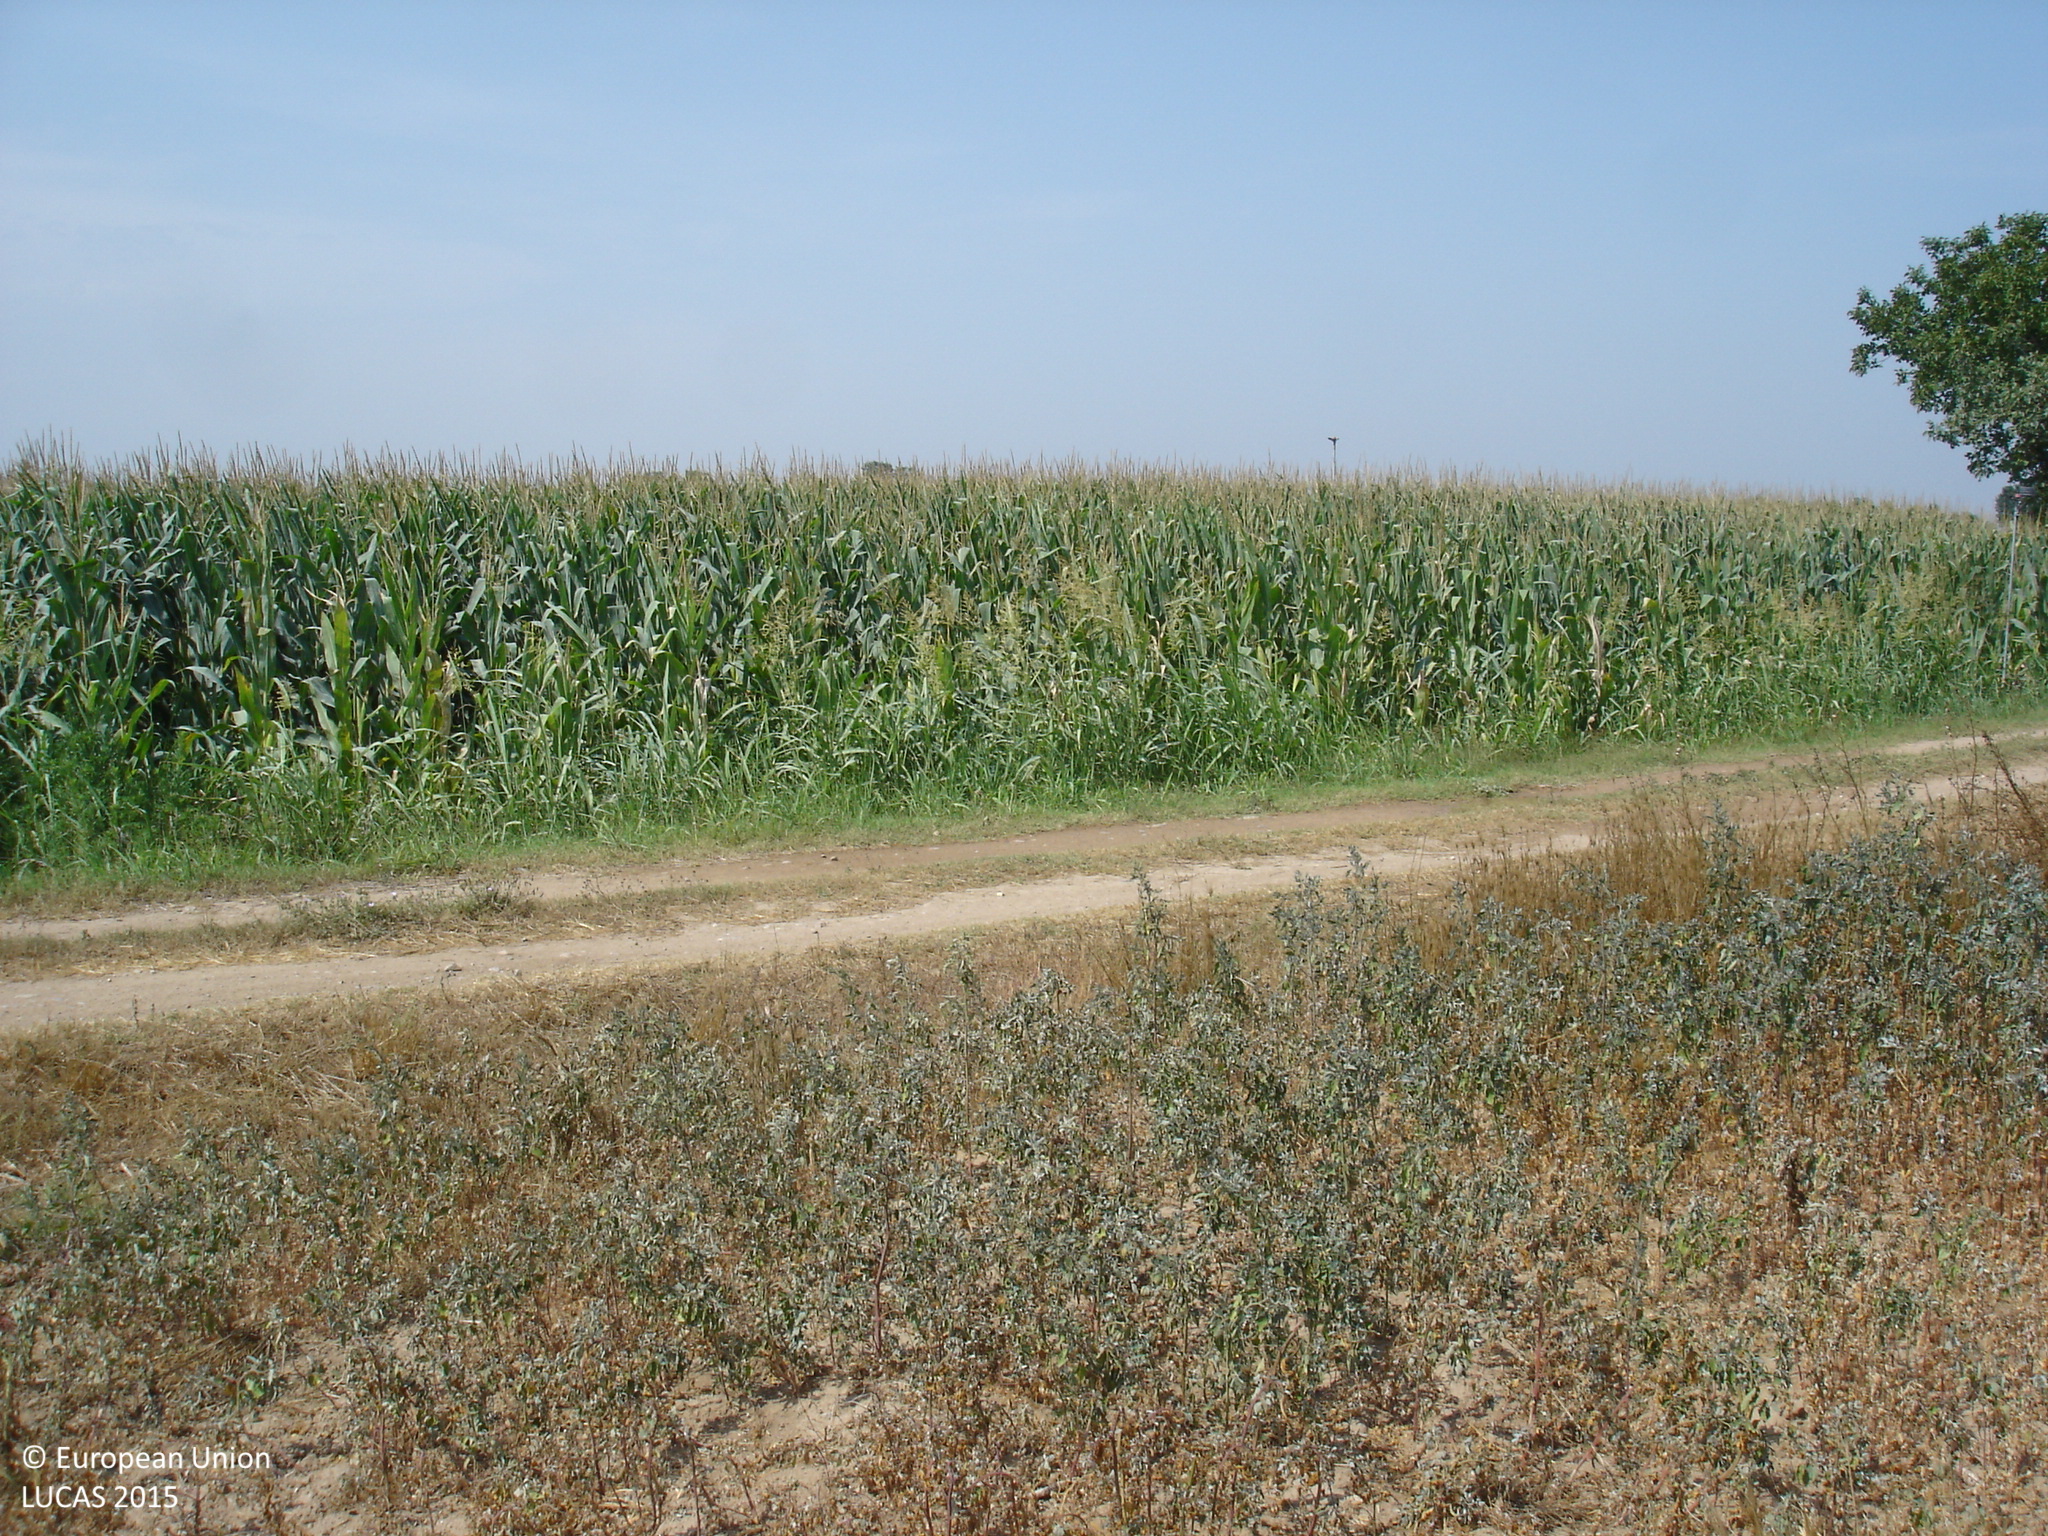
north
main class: Cropland
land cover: Maize
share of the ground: 10 - 25 %
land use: Agriculture (excluding fallow land and kitchen gardens)
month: July
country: ES
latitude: 42.0506
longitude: 3.0197
